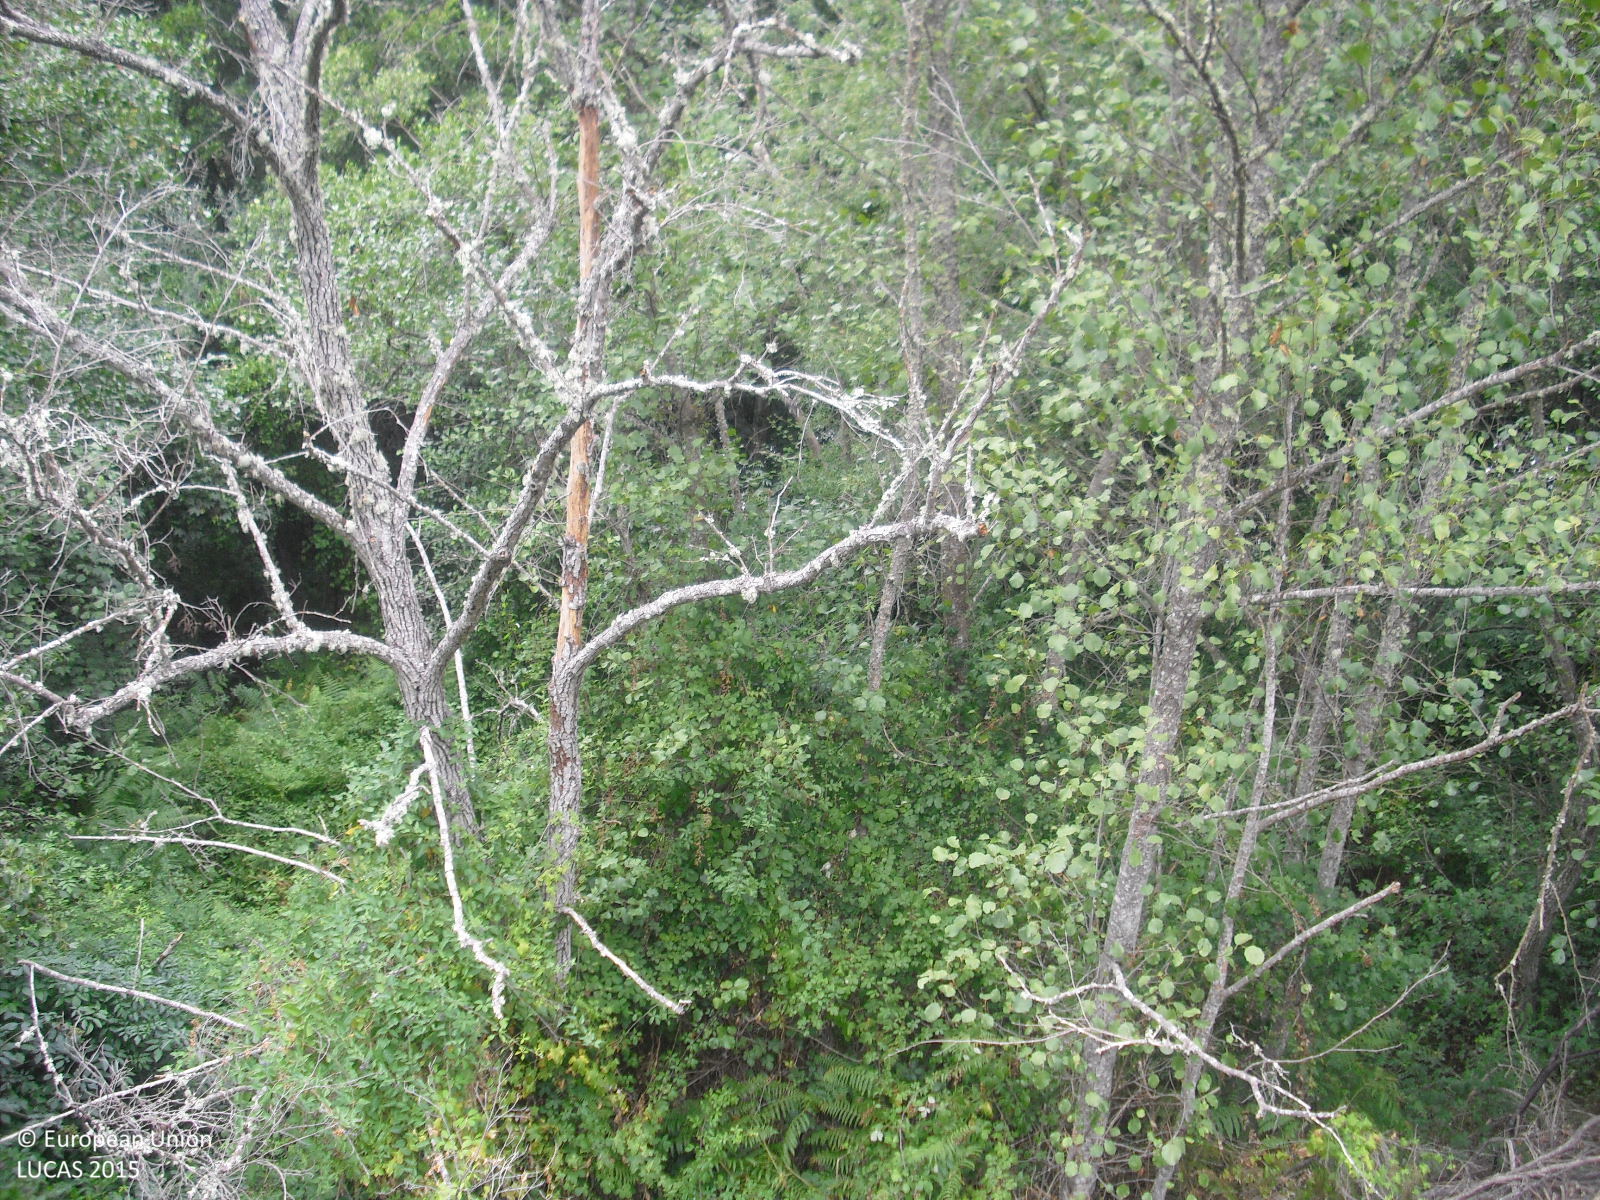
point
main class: Woodland
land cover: Broadleaved woodland
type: floodplain forest
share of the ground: 50 - 75 %
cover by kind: broadleaved forest trees 60 %, consolidated bare surface 30 %, shrubs 10 %
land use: Semi-natural and natural areas not in use
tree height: > 5 m
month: July
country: ES
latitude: 42.3858
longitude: -7.1982
